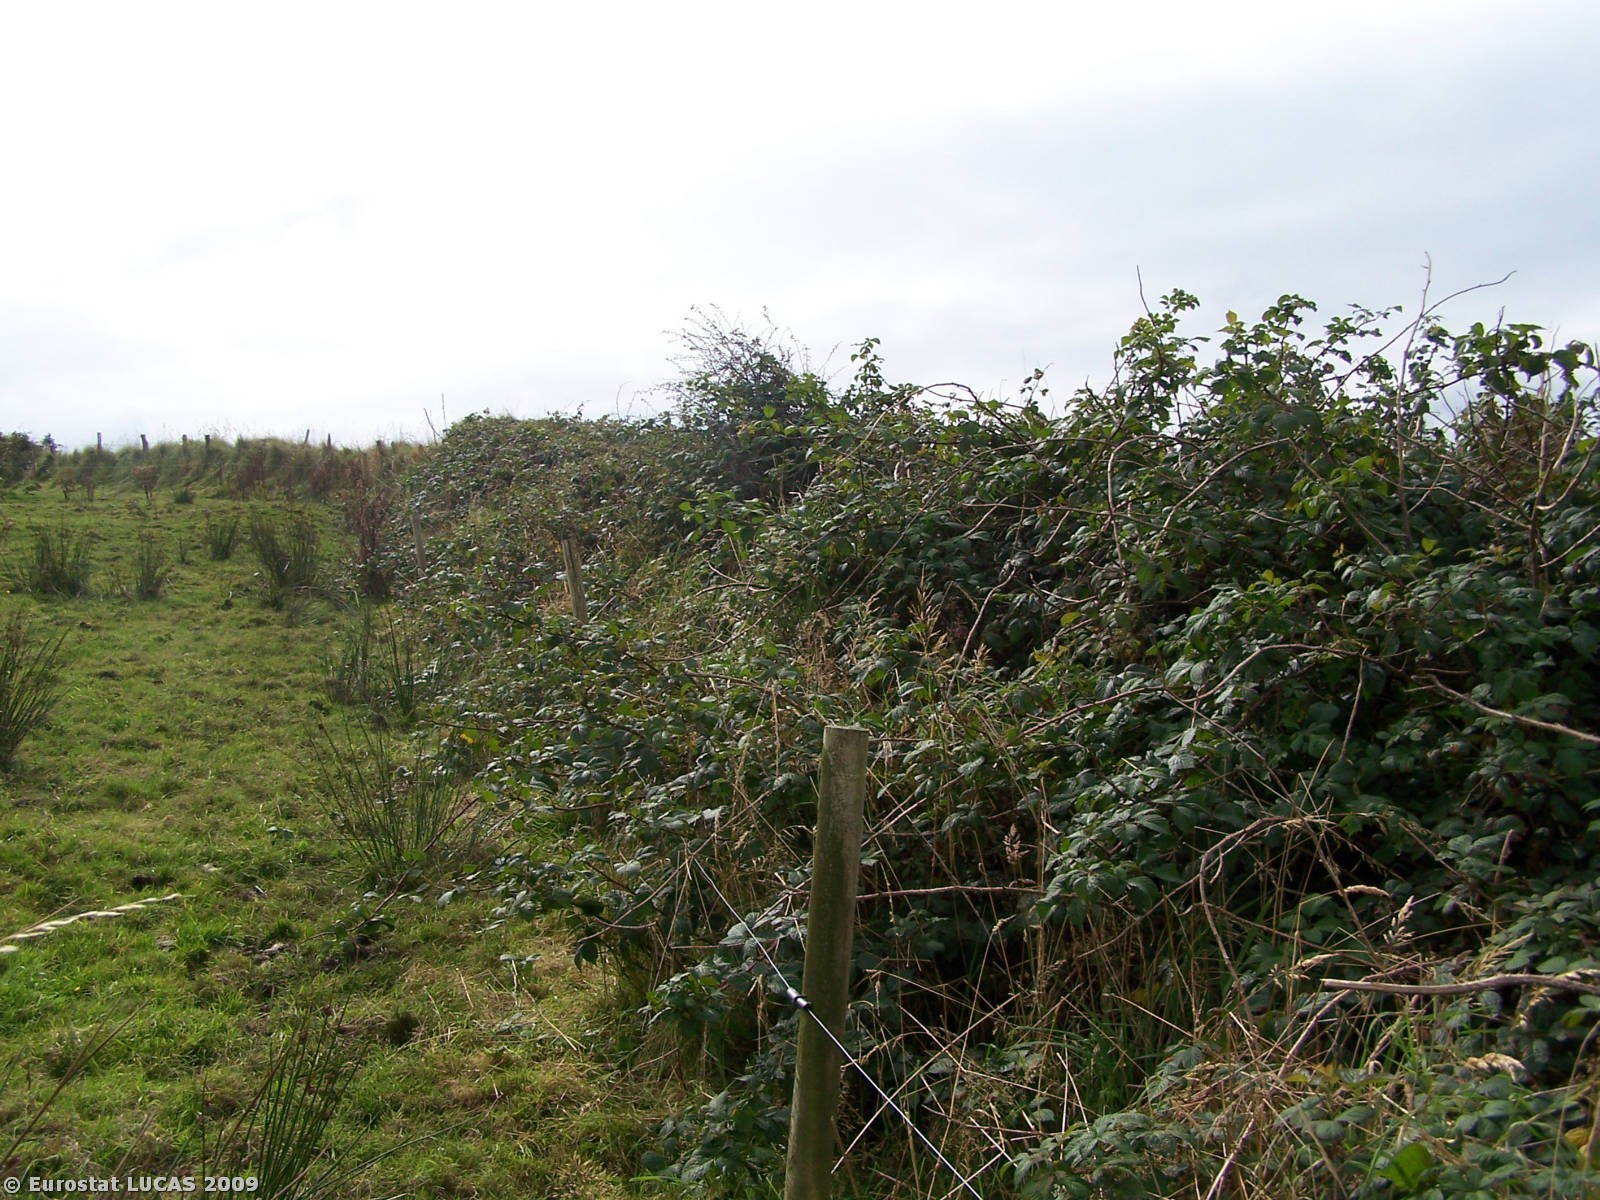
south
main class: Grassland
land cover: Grassland without tree/shrub cover
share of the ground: > 75 %
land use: Agriculture (excluding fallow land and kitchen gardens)
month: September
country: IE
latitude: 52.2801
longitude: -9.0196
